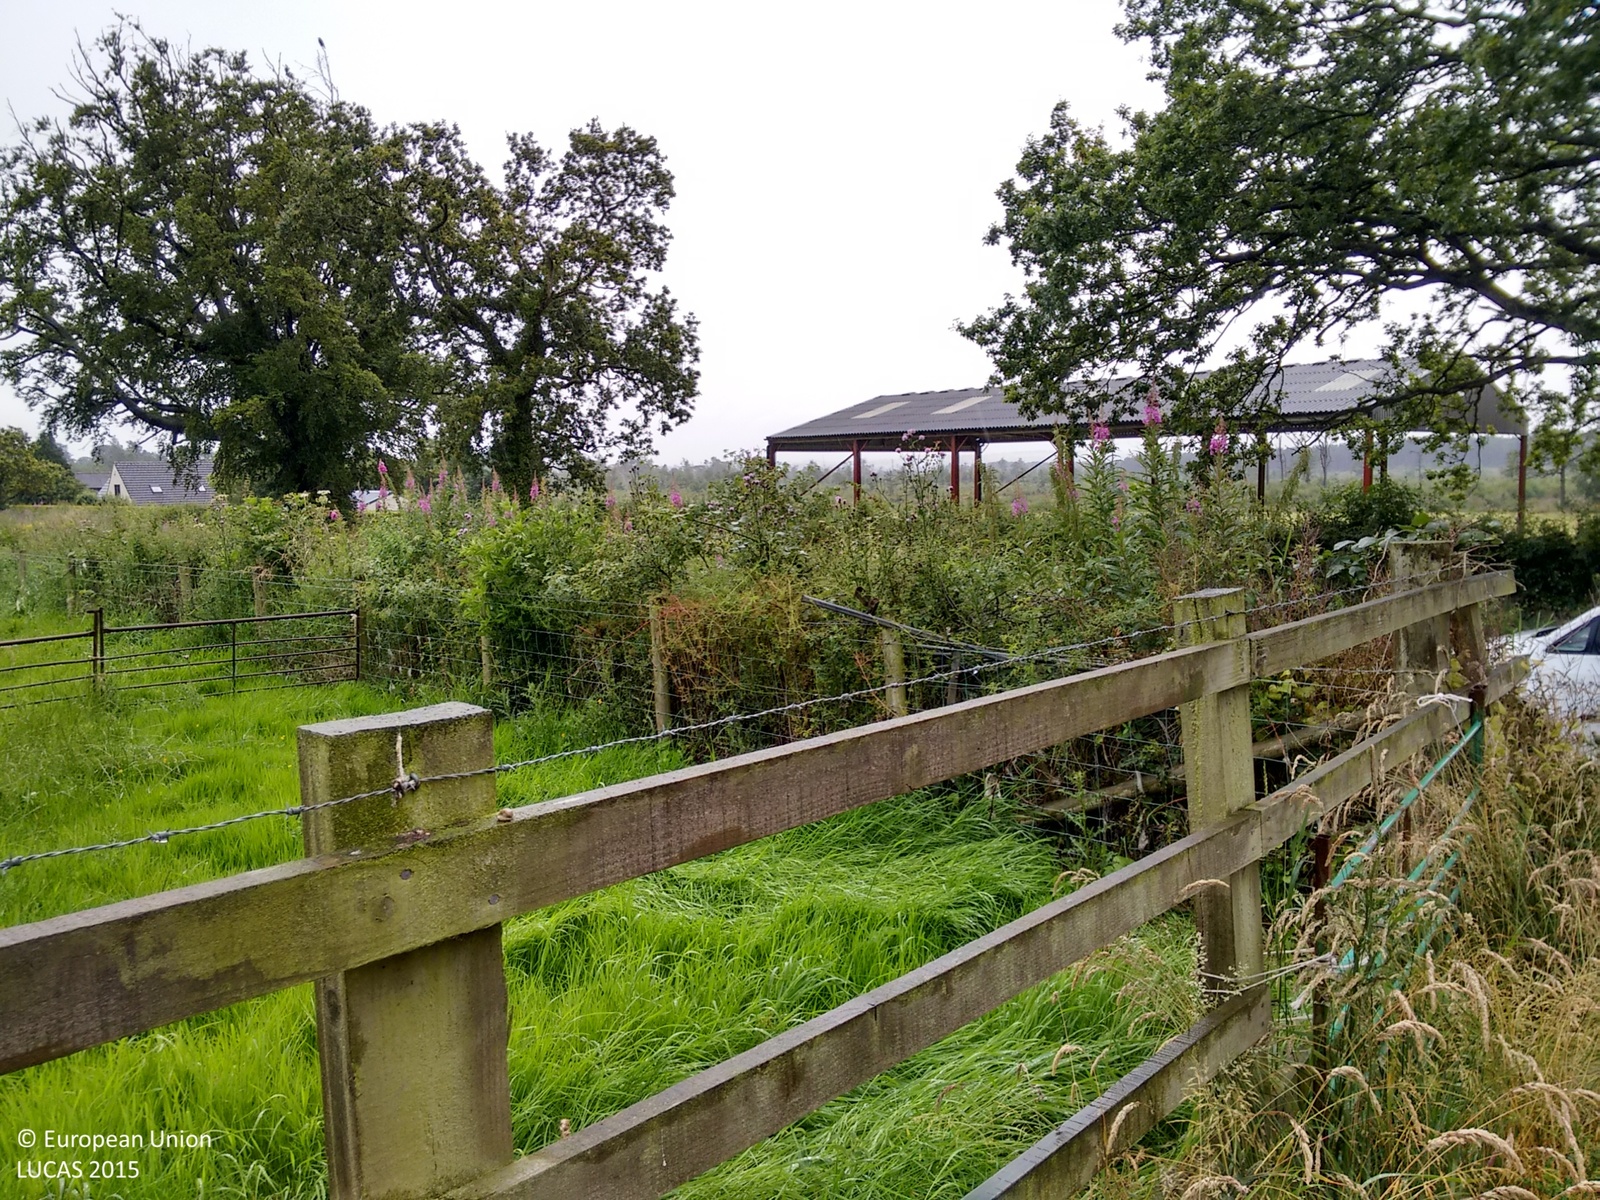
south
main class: Cropland
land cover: Temporary grasslands
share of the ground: > 75 %
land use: Agriculture (excluding fallow land and kitchen gardens)
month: July
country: GB
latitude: 54.8675
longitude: -2.9885
